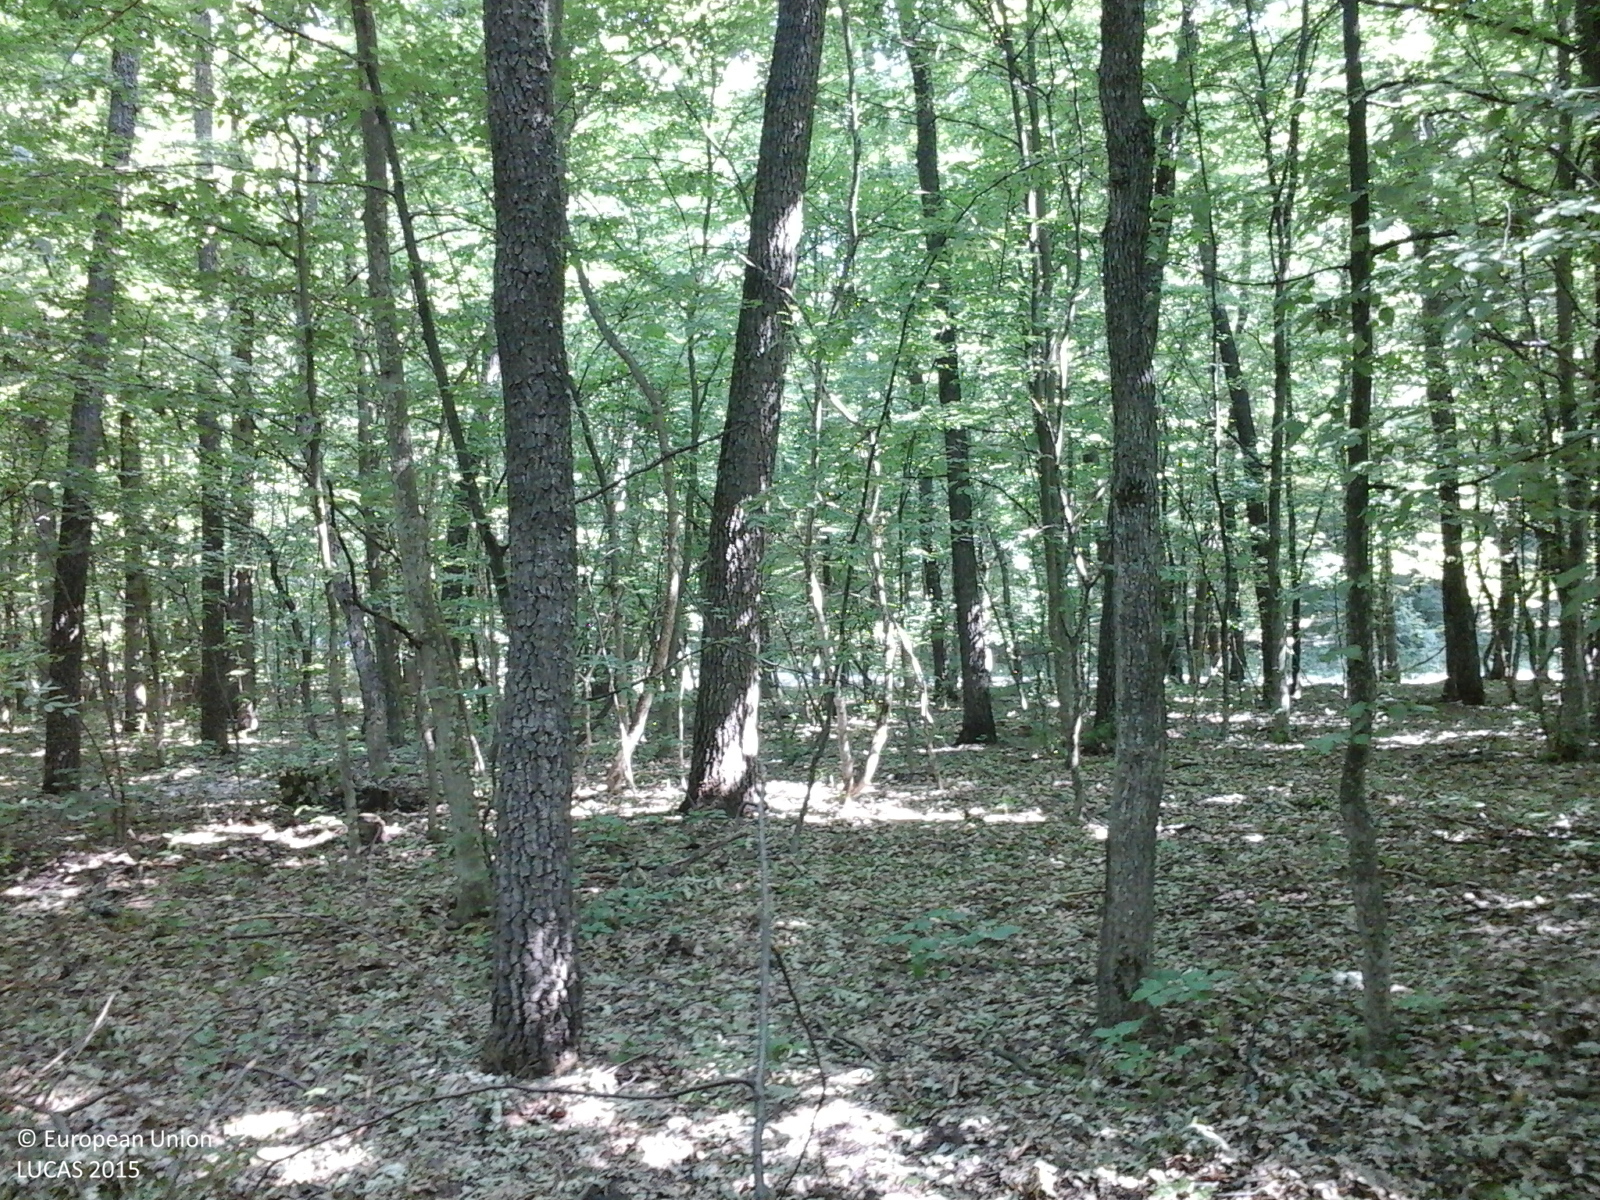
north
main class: Woodland
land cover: Broadleaved woodland
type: mesophytic deciduous forest
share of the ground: > 75 %
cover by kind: broadleaved forest trees 95 %, herbaceous plants 5 %
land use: Forestry
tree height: > 5 m
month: June
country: RO
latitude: 46.8794
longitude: 27.9606
